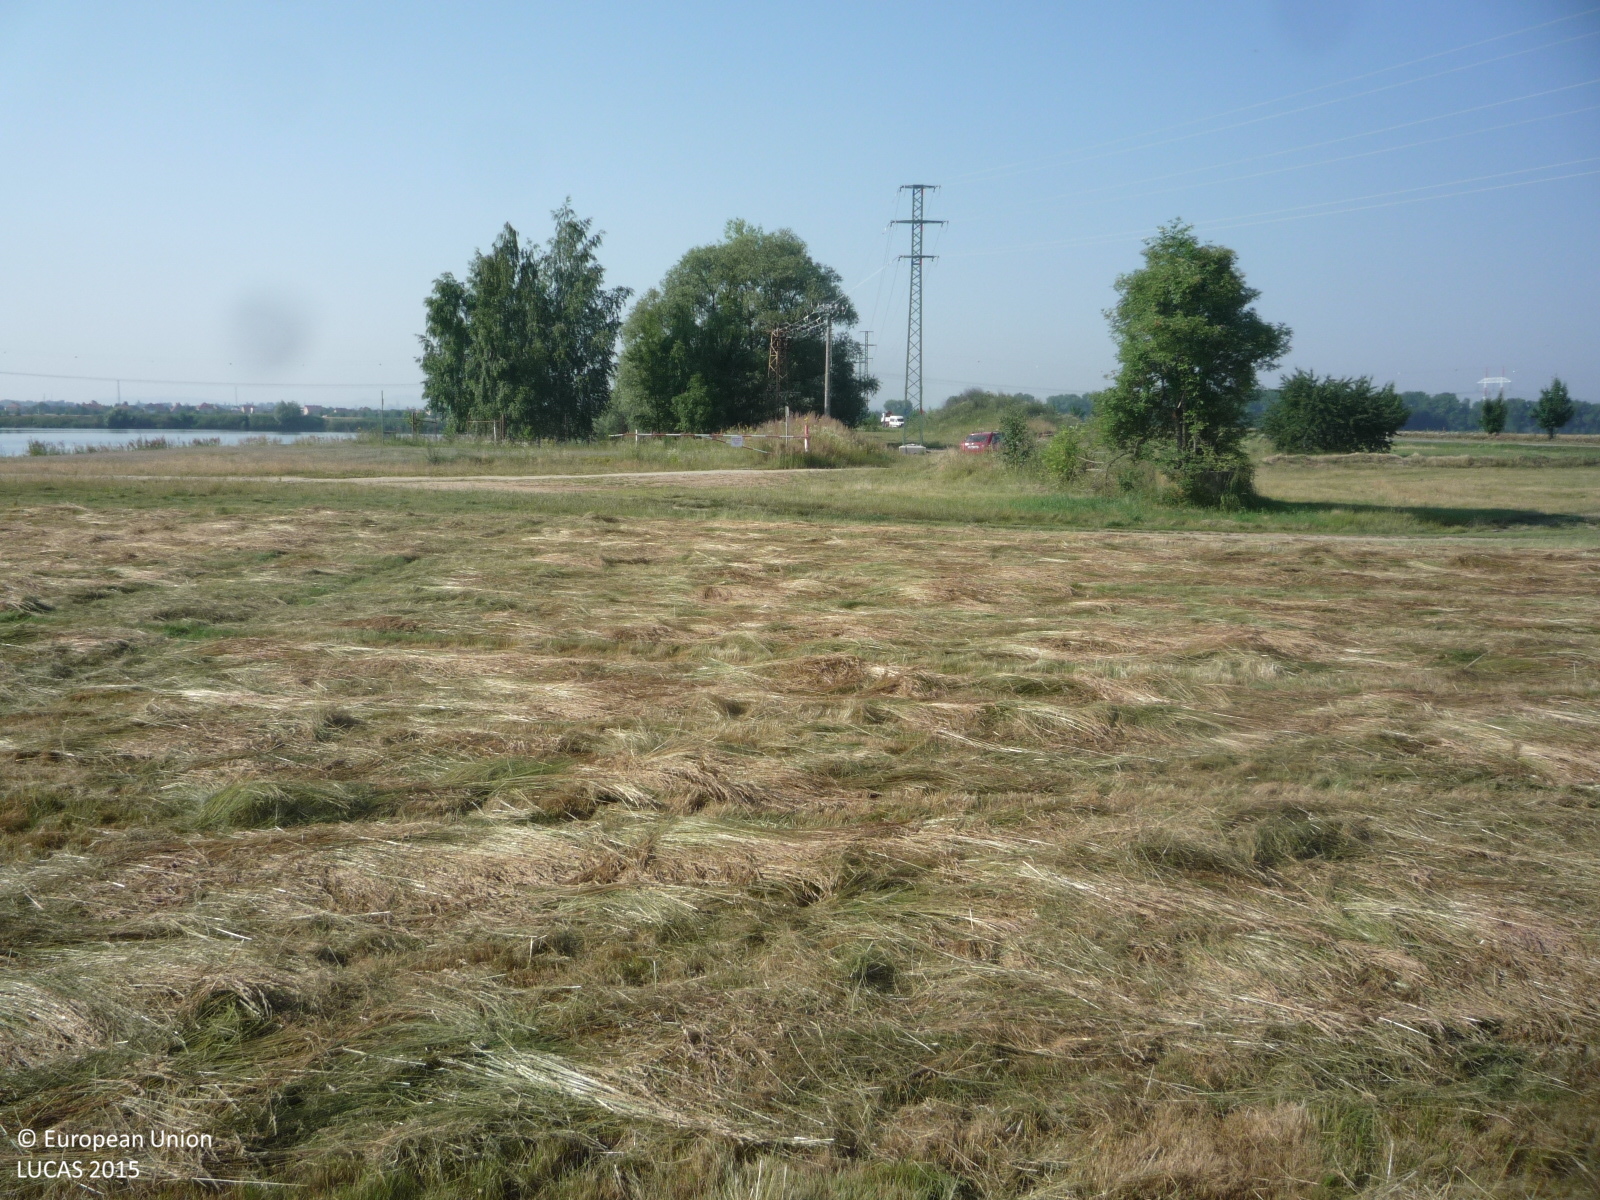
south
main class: Grassland
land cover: Grassland without tree/shrub cover
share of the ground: > 75 %
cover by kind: herbaceous plants 100 %
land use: Agriculture (excluding fallow land and kitchen gardens)
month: July
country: CZ
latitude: 50.0842
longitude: 15.1881
